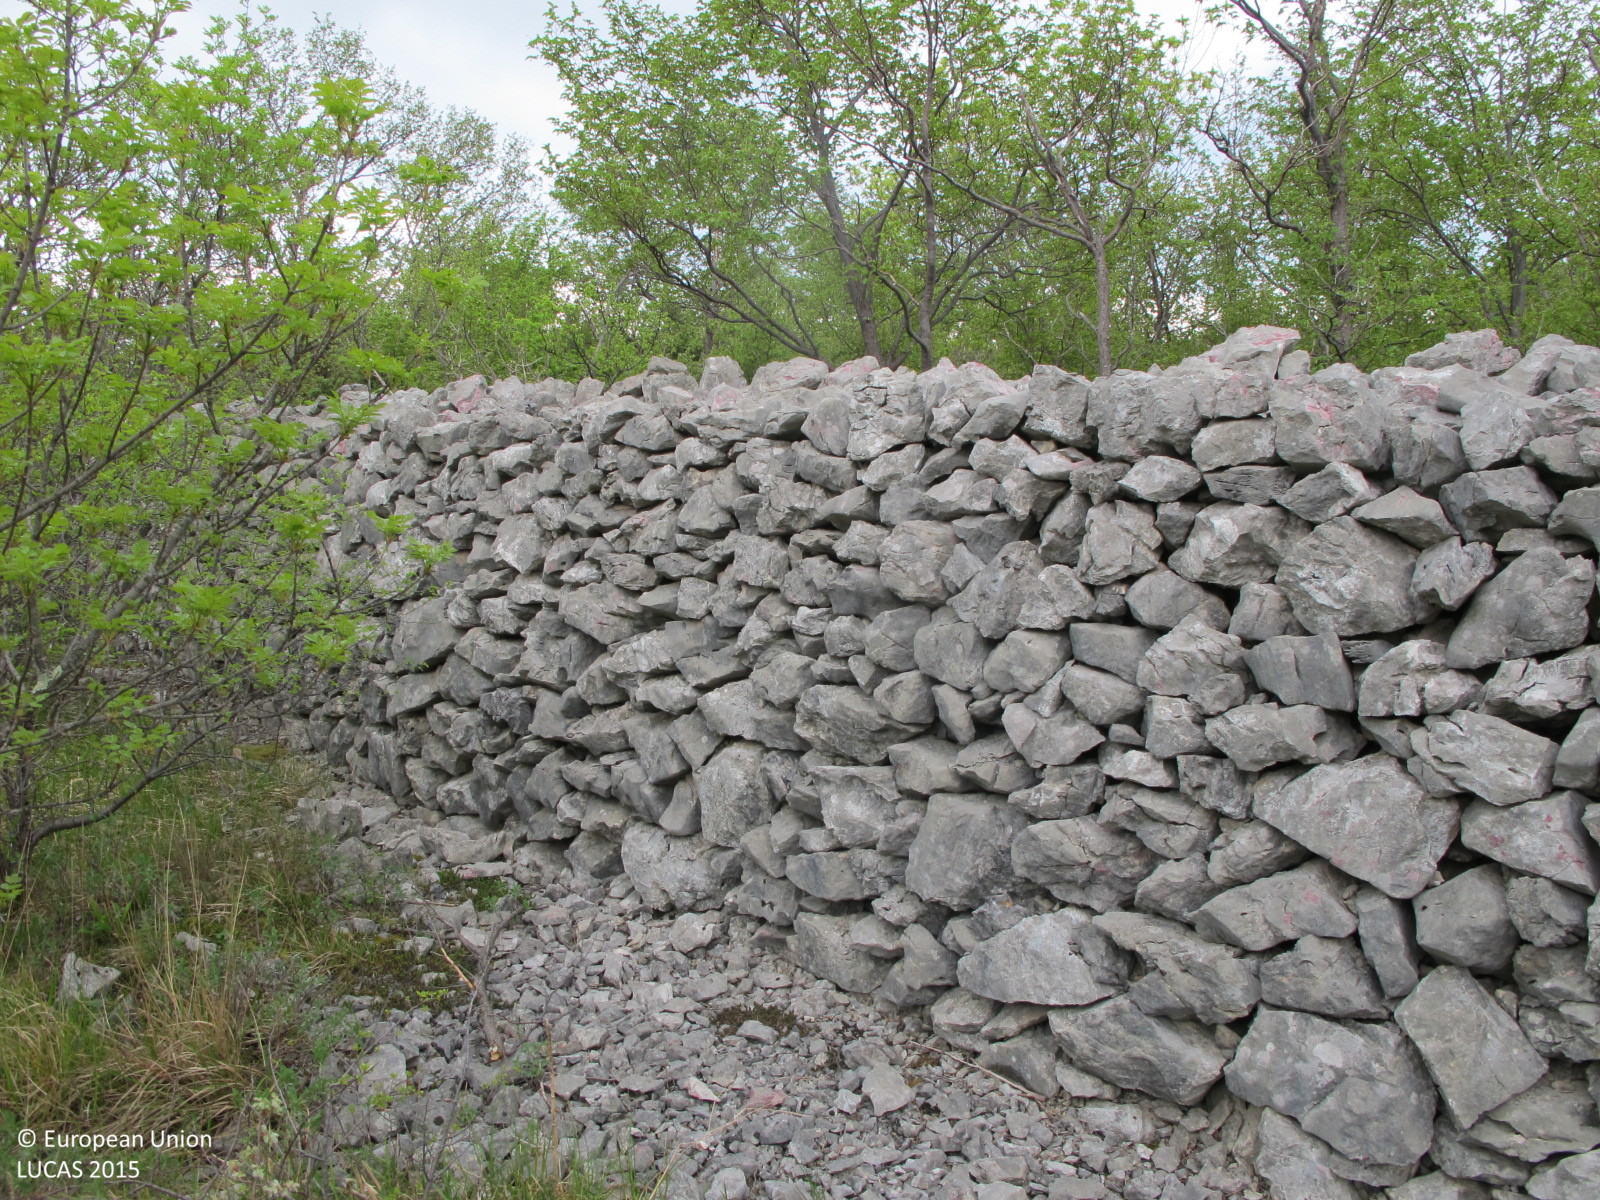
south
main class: Woodland
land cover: Broadleaved woodland
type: thermophilous deciduous forest
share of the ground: > 75 %
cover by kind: broadleaved forest trees 65 %, coniferous forest trees 10 %, shrubs 10 %, herbaceous plants 10 %
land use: Semi-natural and natural areas not in use
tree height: < 5 m
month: April
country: HR
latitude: 45.2218
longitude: 14.6431
